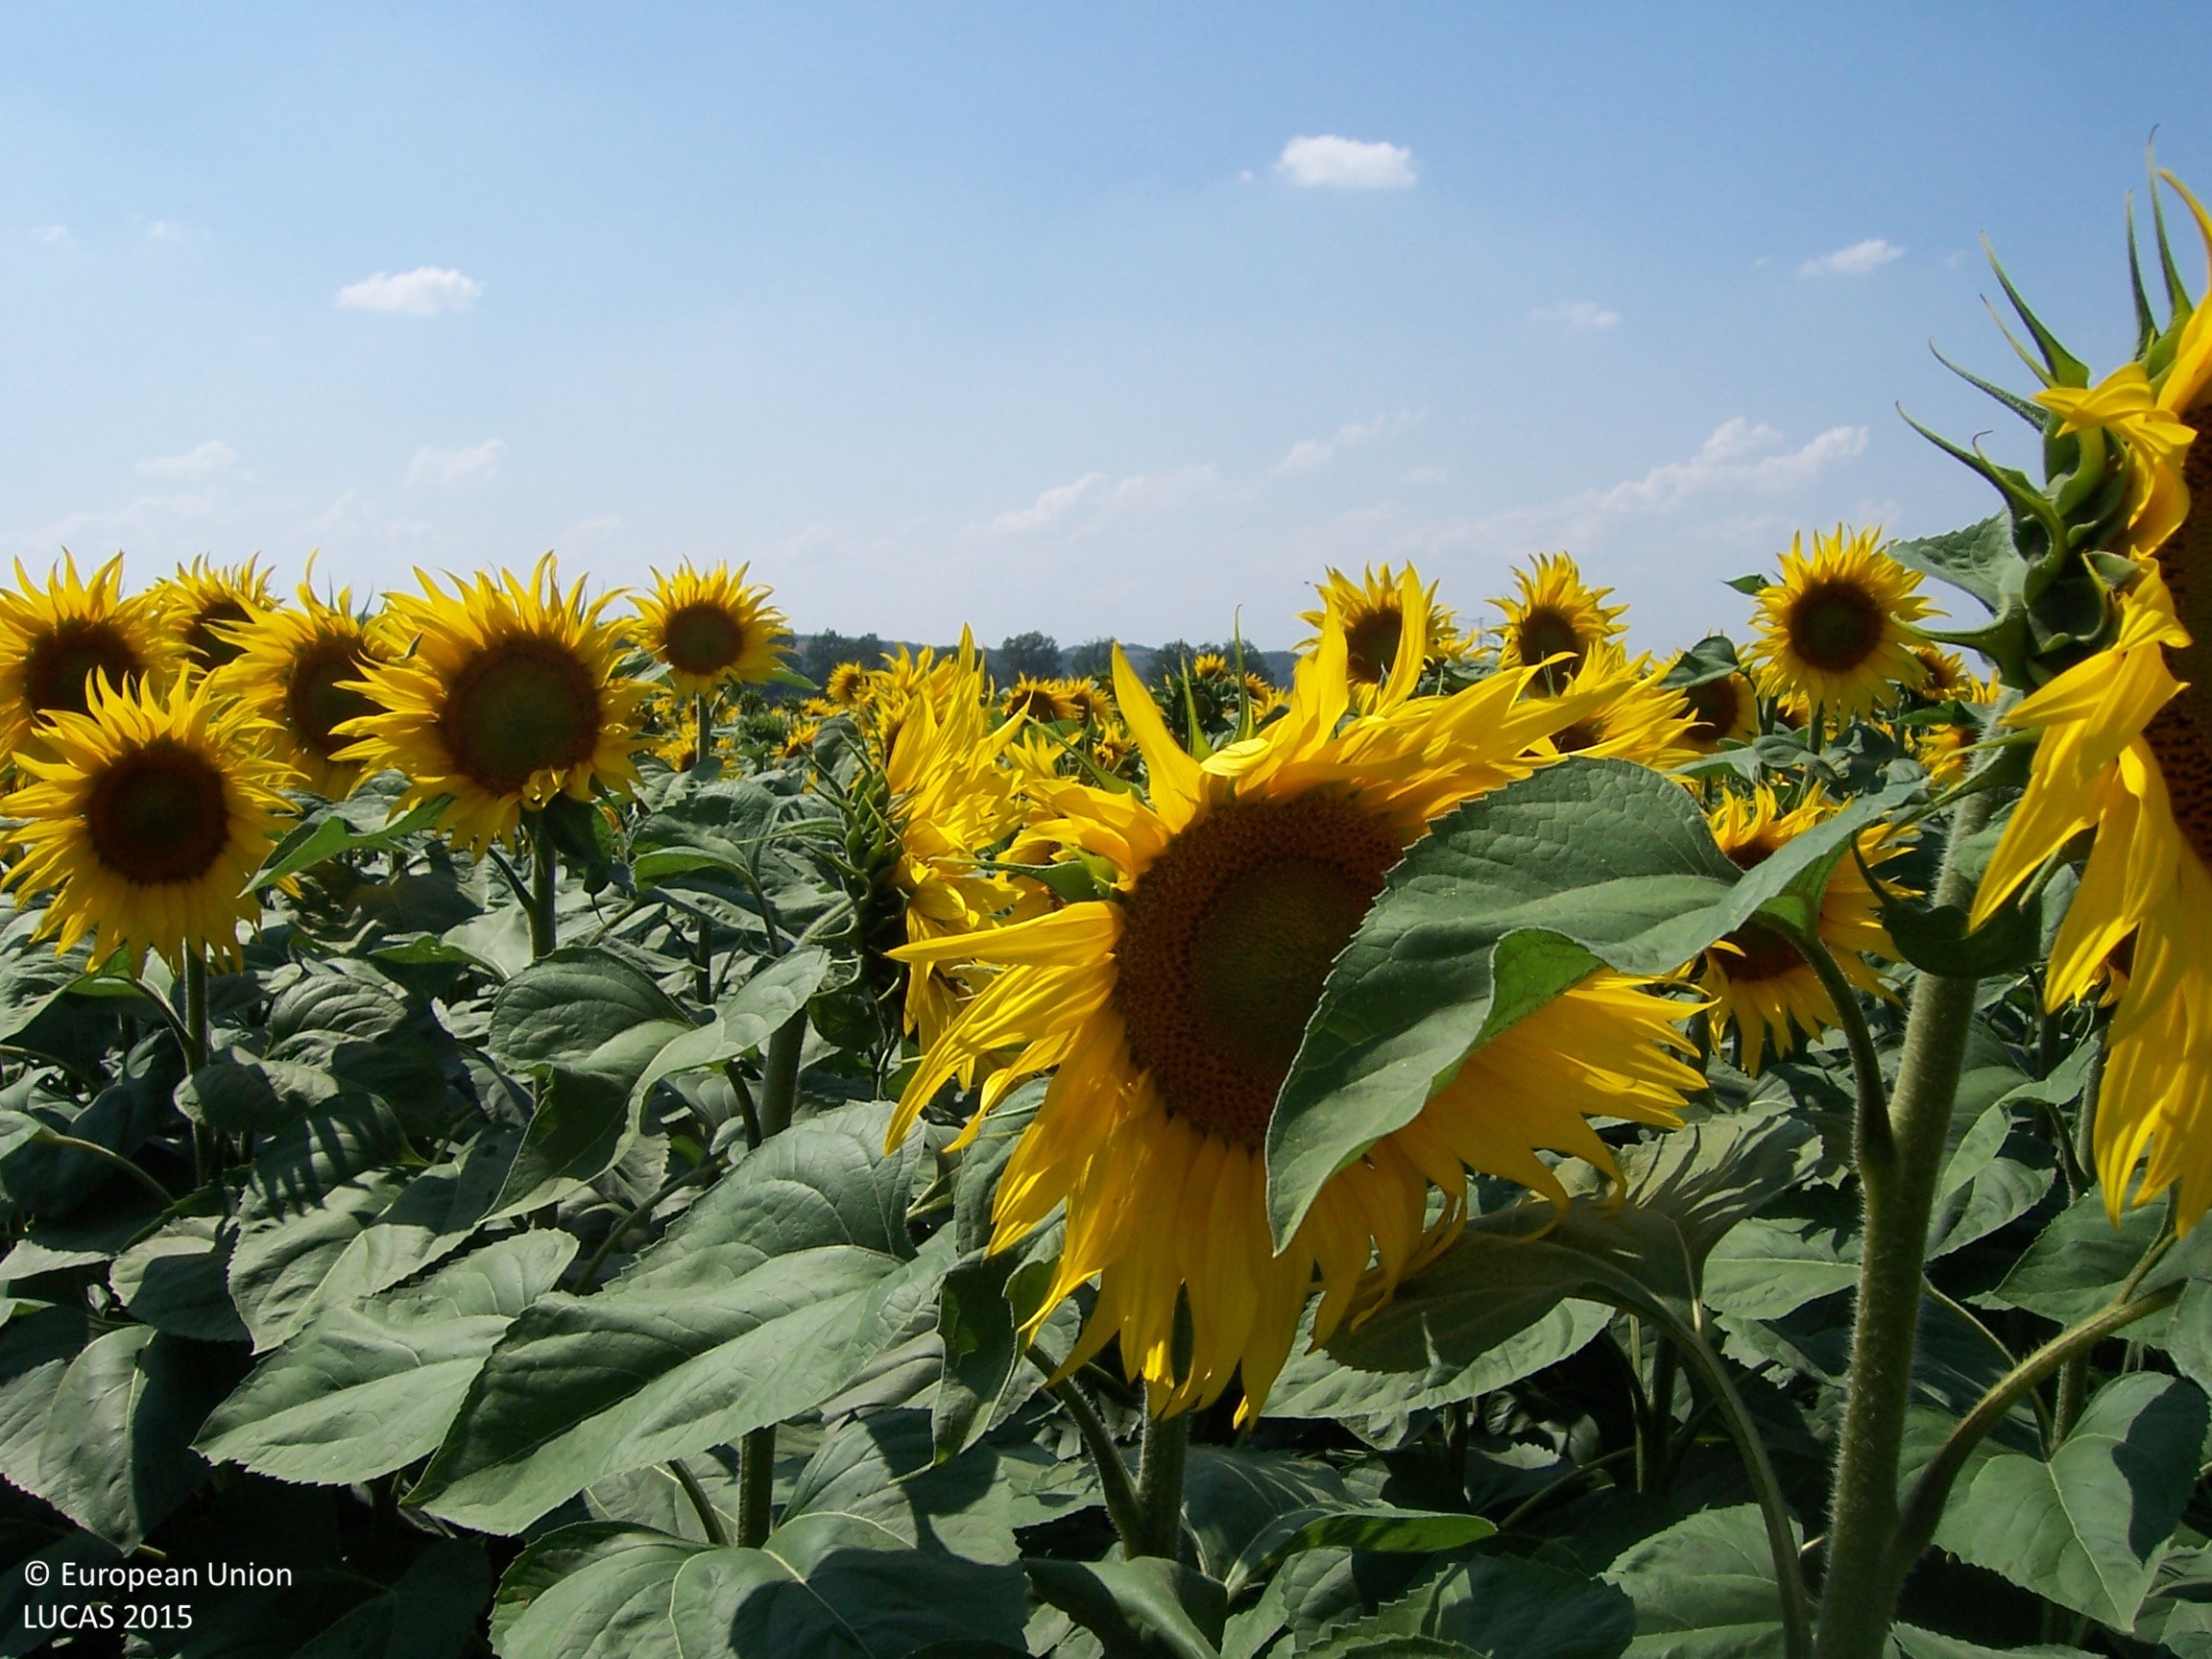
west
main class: Cropland
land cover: Sunflower
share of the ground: > 75 %
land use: Agriculture (excluding fallow land and kitchen gardens)
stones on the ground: < 10 %
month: July
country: SK
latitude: 48.3740
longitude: 20.3061
